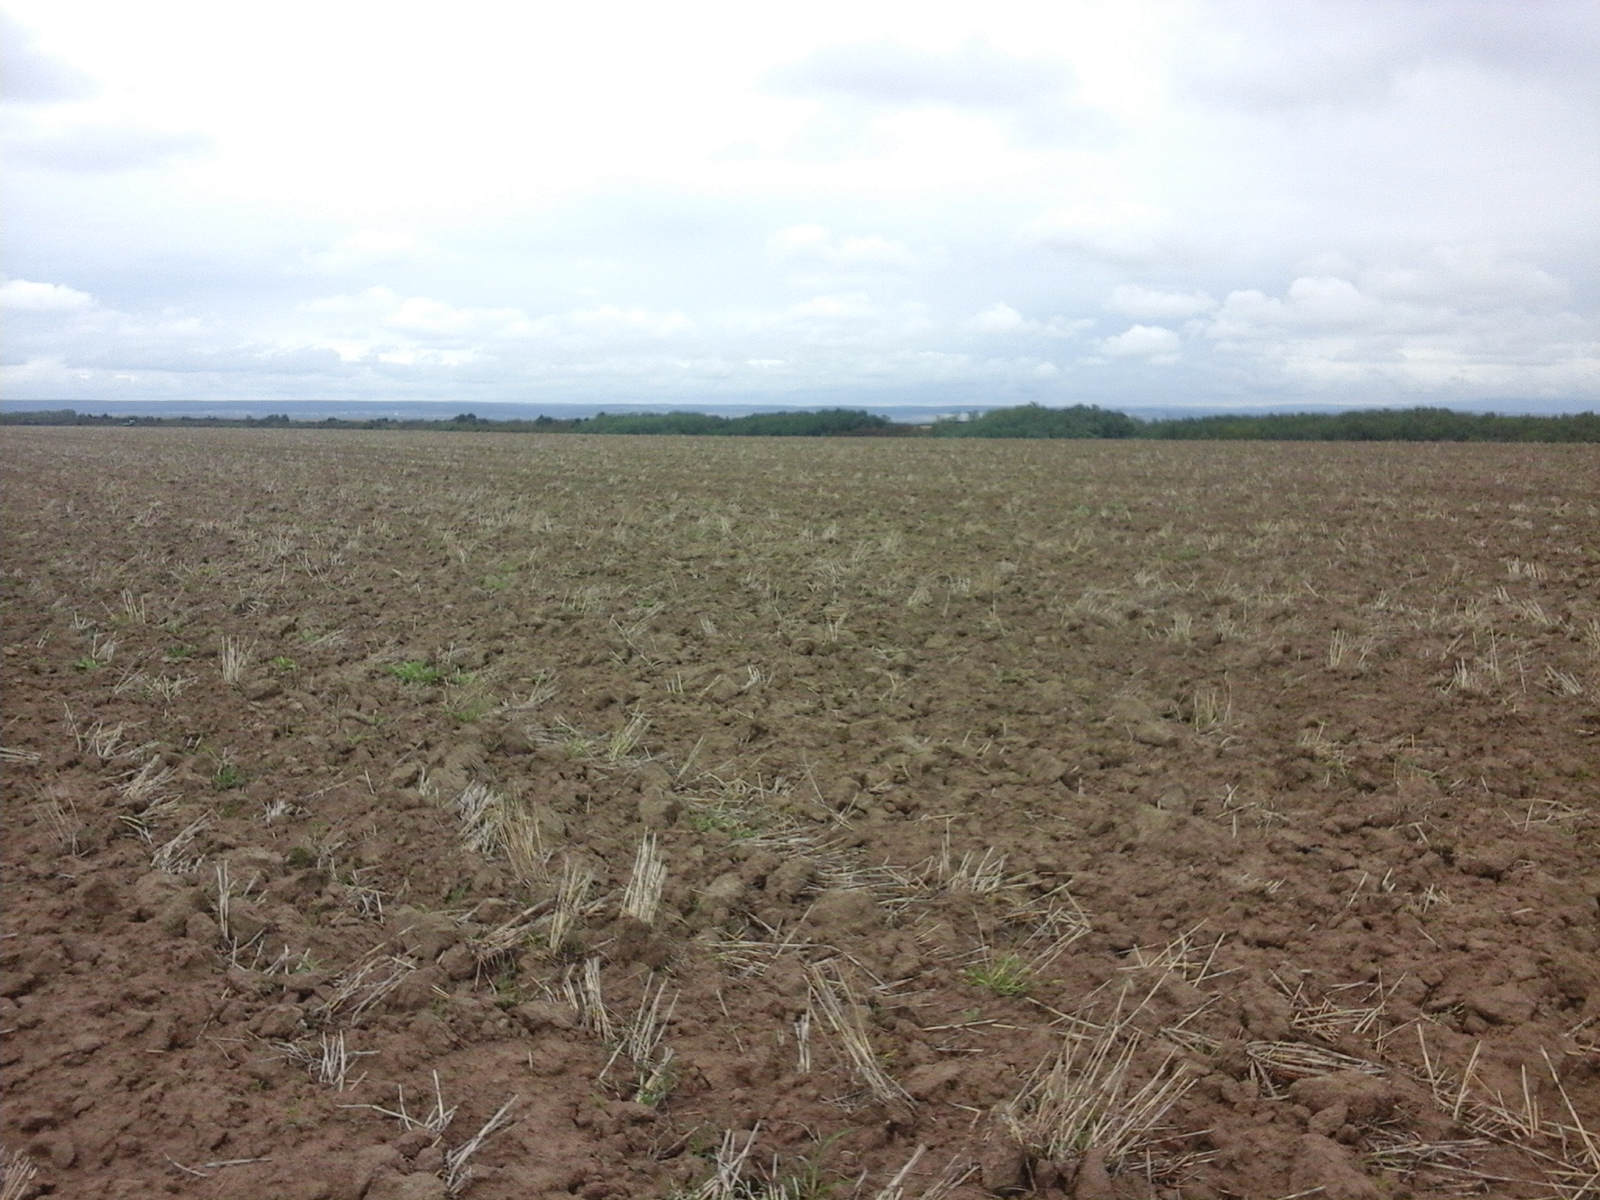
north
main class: Cropland
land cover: Common wheat
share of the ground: 10 - 25 %
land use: Agriculture (excluding fallow land and kitchen gardens)
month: September
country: RO
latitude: 46.6909
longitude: 22.0101
